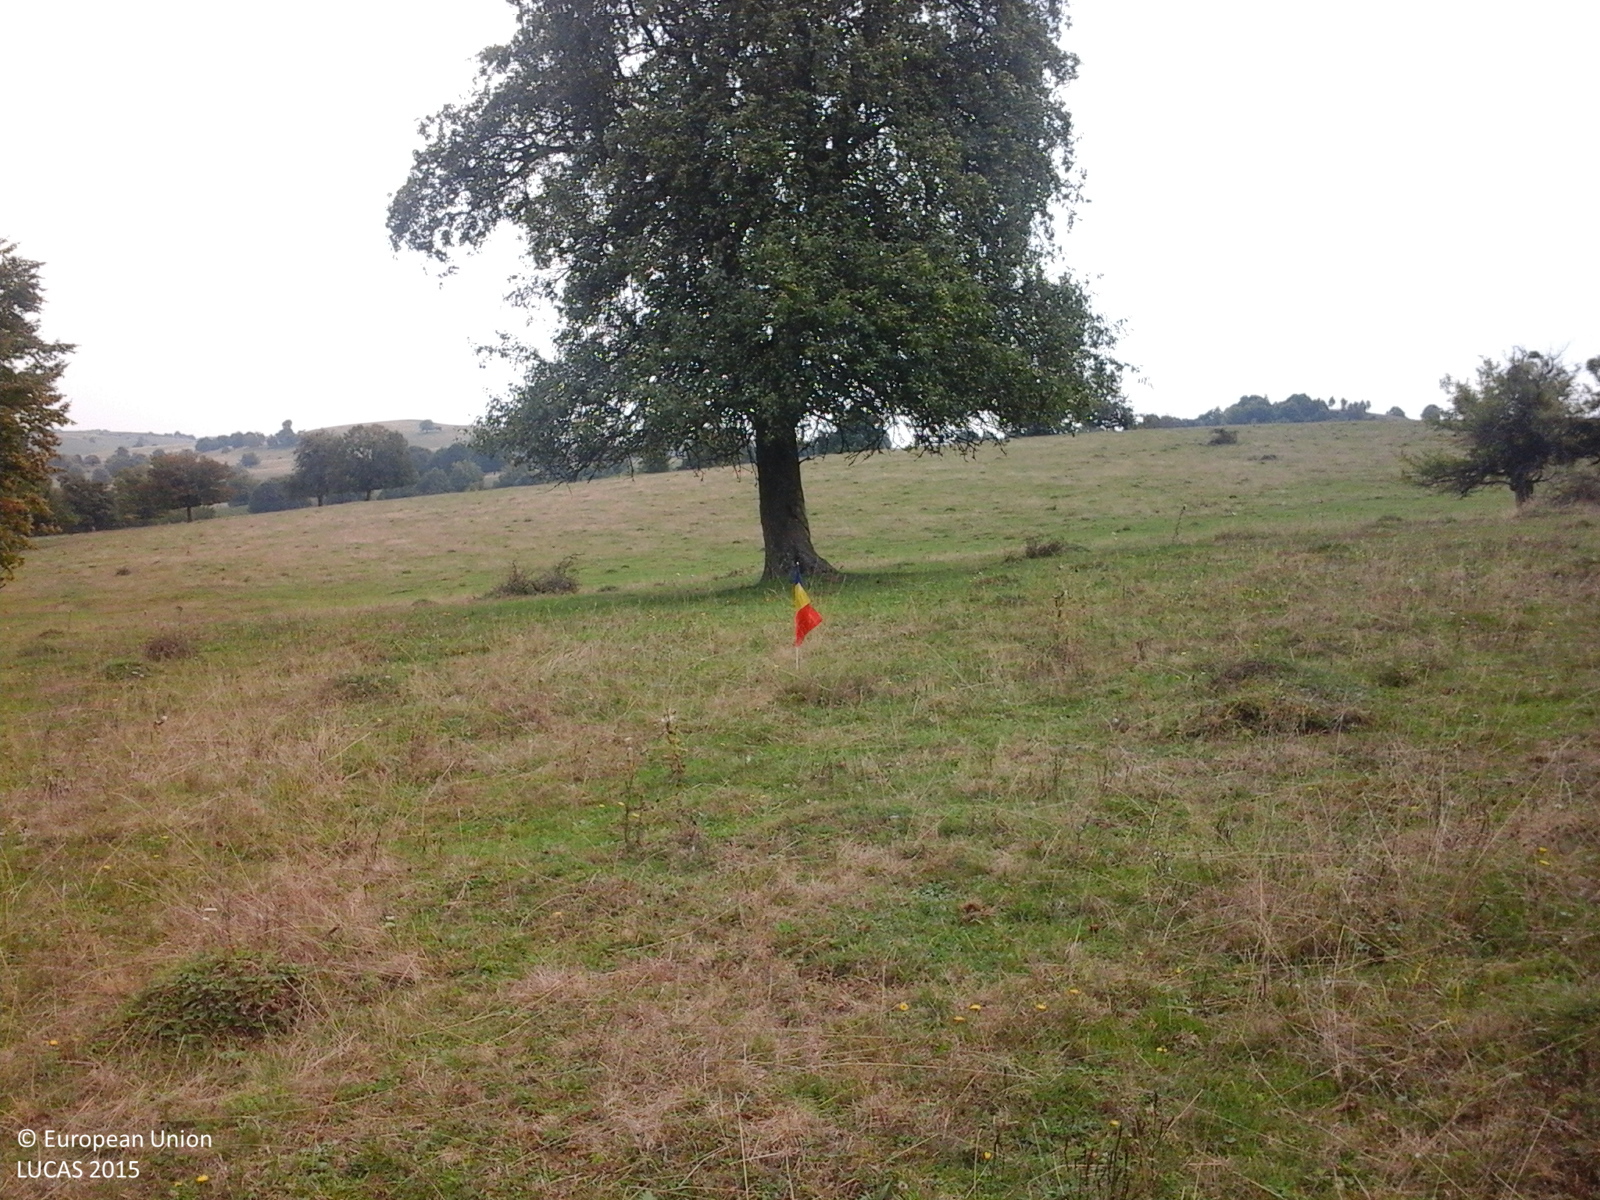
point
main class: Grassland
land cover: Grassland with sparse tree/shrub cover
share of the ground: > 75 %
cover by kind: herbaceous plants 90 %, broadleaved forest trees 5 %, shrubs 5 %
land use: Agriculture (excluding fallow land and kitchen gardens)
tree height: > 5 m
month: September
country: RO
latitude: 46.8894
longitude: 22.9620
